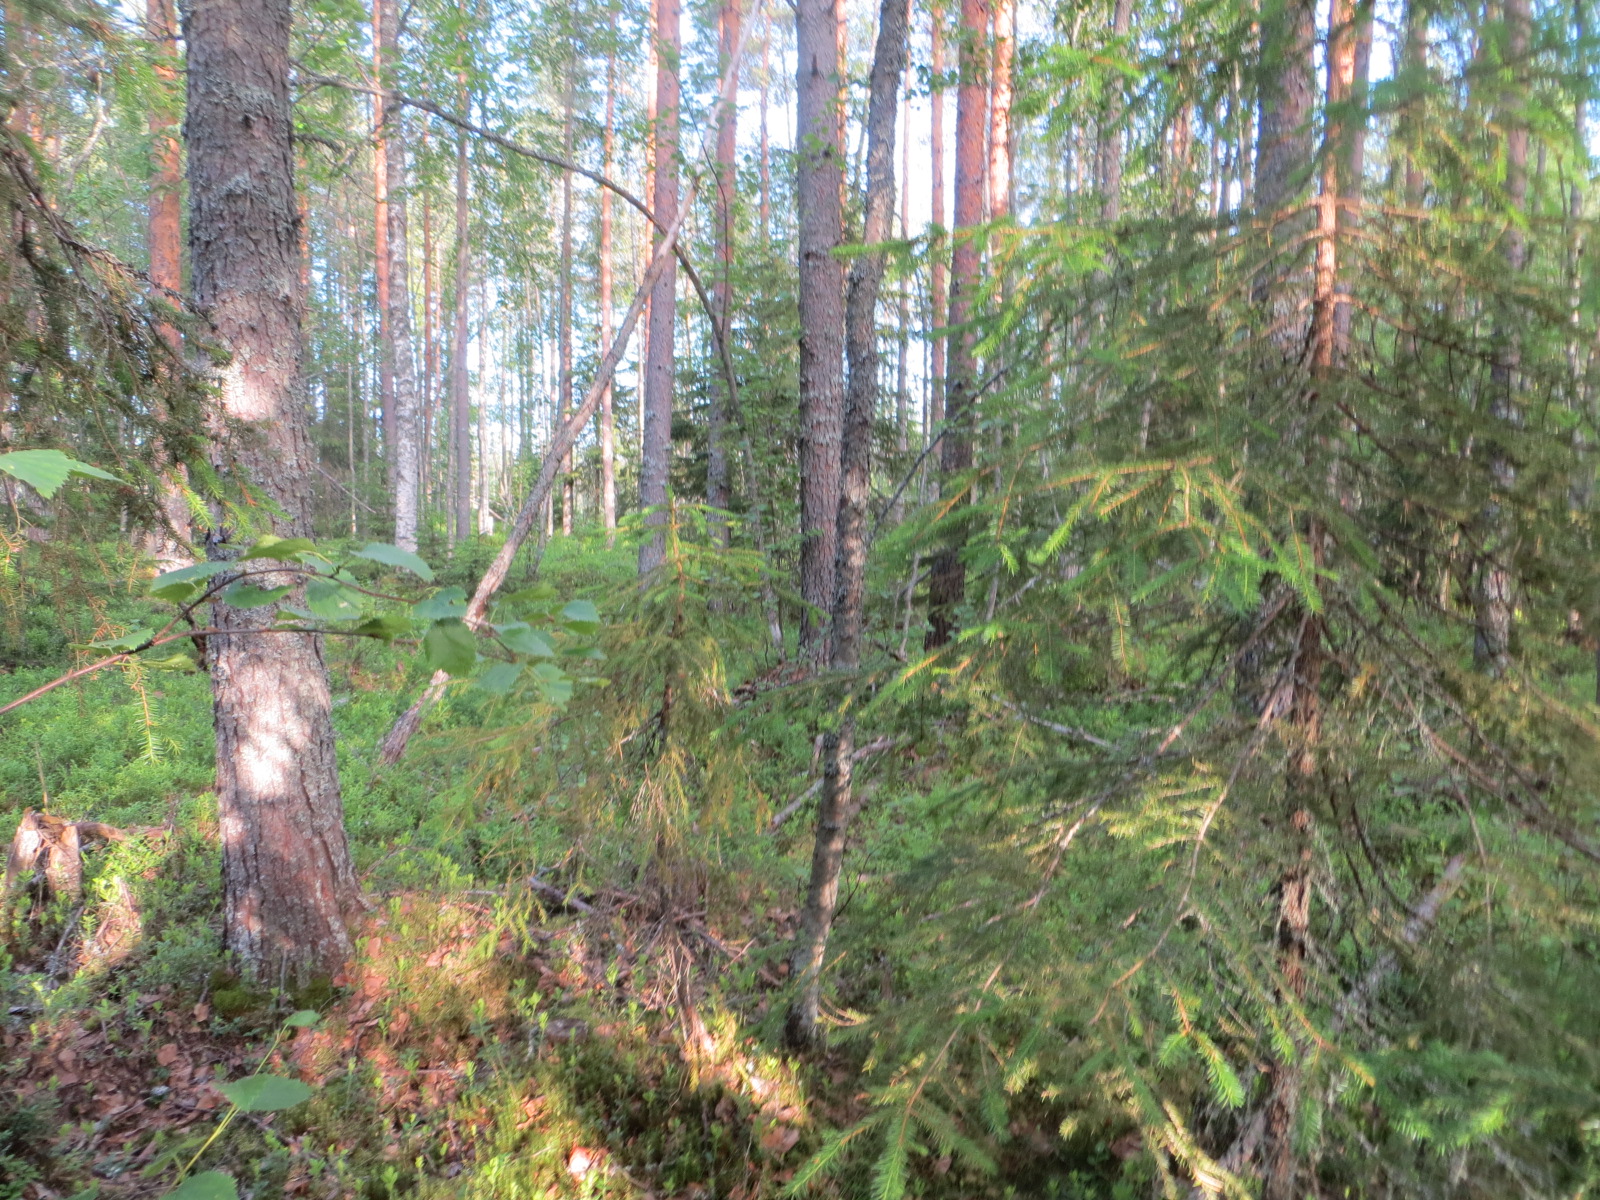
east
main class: Woodland
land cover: Pine dominated mixed woodland
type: boreal forest
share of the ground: 50 - 75 %
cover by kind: shrubs 40 %, coniferous forest trees 35 %, broadleaved forest trees 25 %
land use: Forestry
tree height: > 5 m
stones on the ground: 25 - 50 %
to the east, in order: Pine dominated mixed woodland; Other mixed woodland; Grassland with sparse tree/shrub cover; Ditches and canals; Pine dominated coniferous woodland; Ditches and canals; Pine dominated coniferous woodland
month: July
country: FI
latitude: 65.6301
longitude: 26.0521
